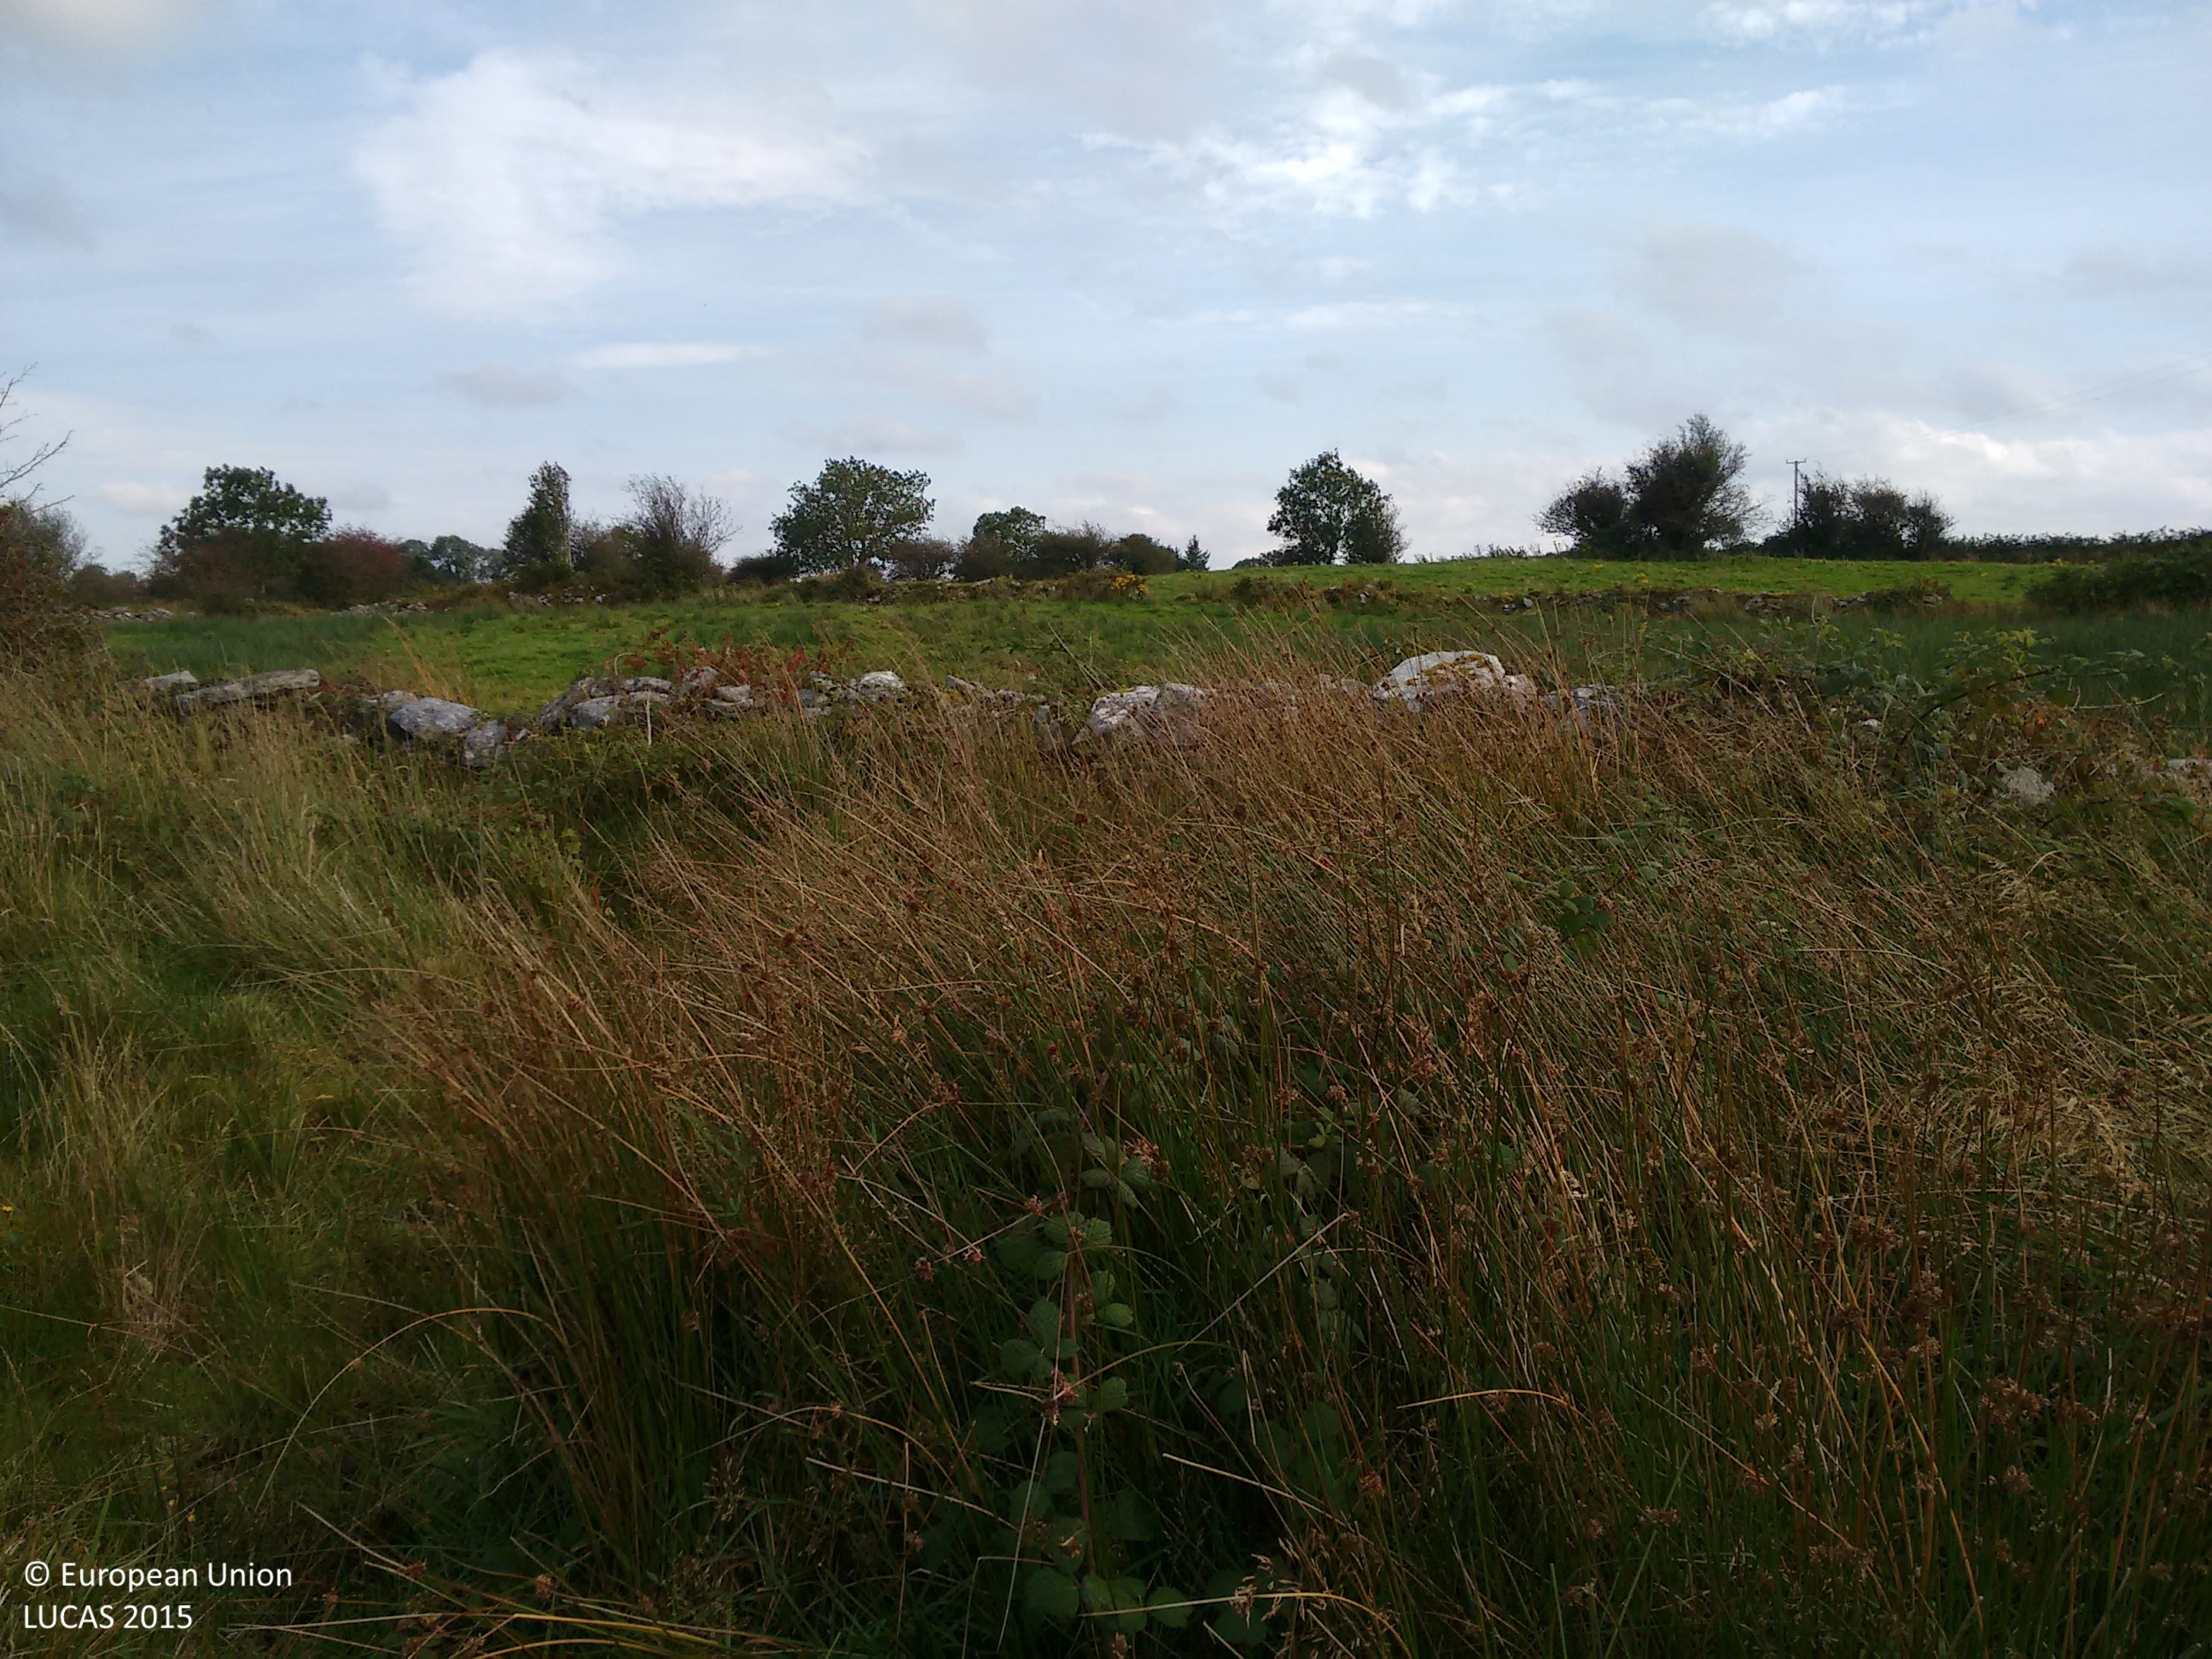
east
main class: Grassland
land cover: Grassland without tree/shrub cover
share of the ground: > 75 %
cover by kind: herbaceous plants 100 %
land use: Agriculture (excluding fallow land and kitchen gardens)
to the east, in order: Grassland without tree/shrub cover; Dry stone walls; Shruby margins; Grassland without tree/shrub cover; Dry stone walls; Shruby margins; Dry stone walls; Shruby margins; Grassland without tree/shrub cover; Abandoned hedges; Dry stone walls; Fences; Abandoned hedges; Grassland without tree/shrub cover; Abandoned hedges; Fences; Dry stone walls; Abandoned hedges; Grassland without tree/shrub cover; Abandoned hedges; Fences; Abandoned hedges; Grassland without tree/shrub cover; Abandoned hedges; Fences; Dry stone walls; Grassland without tree/shrub cover
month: September
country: IE
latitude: 53.8811
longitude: -8.9672
